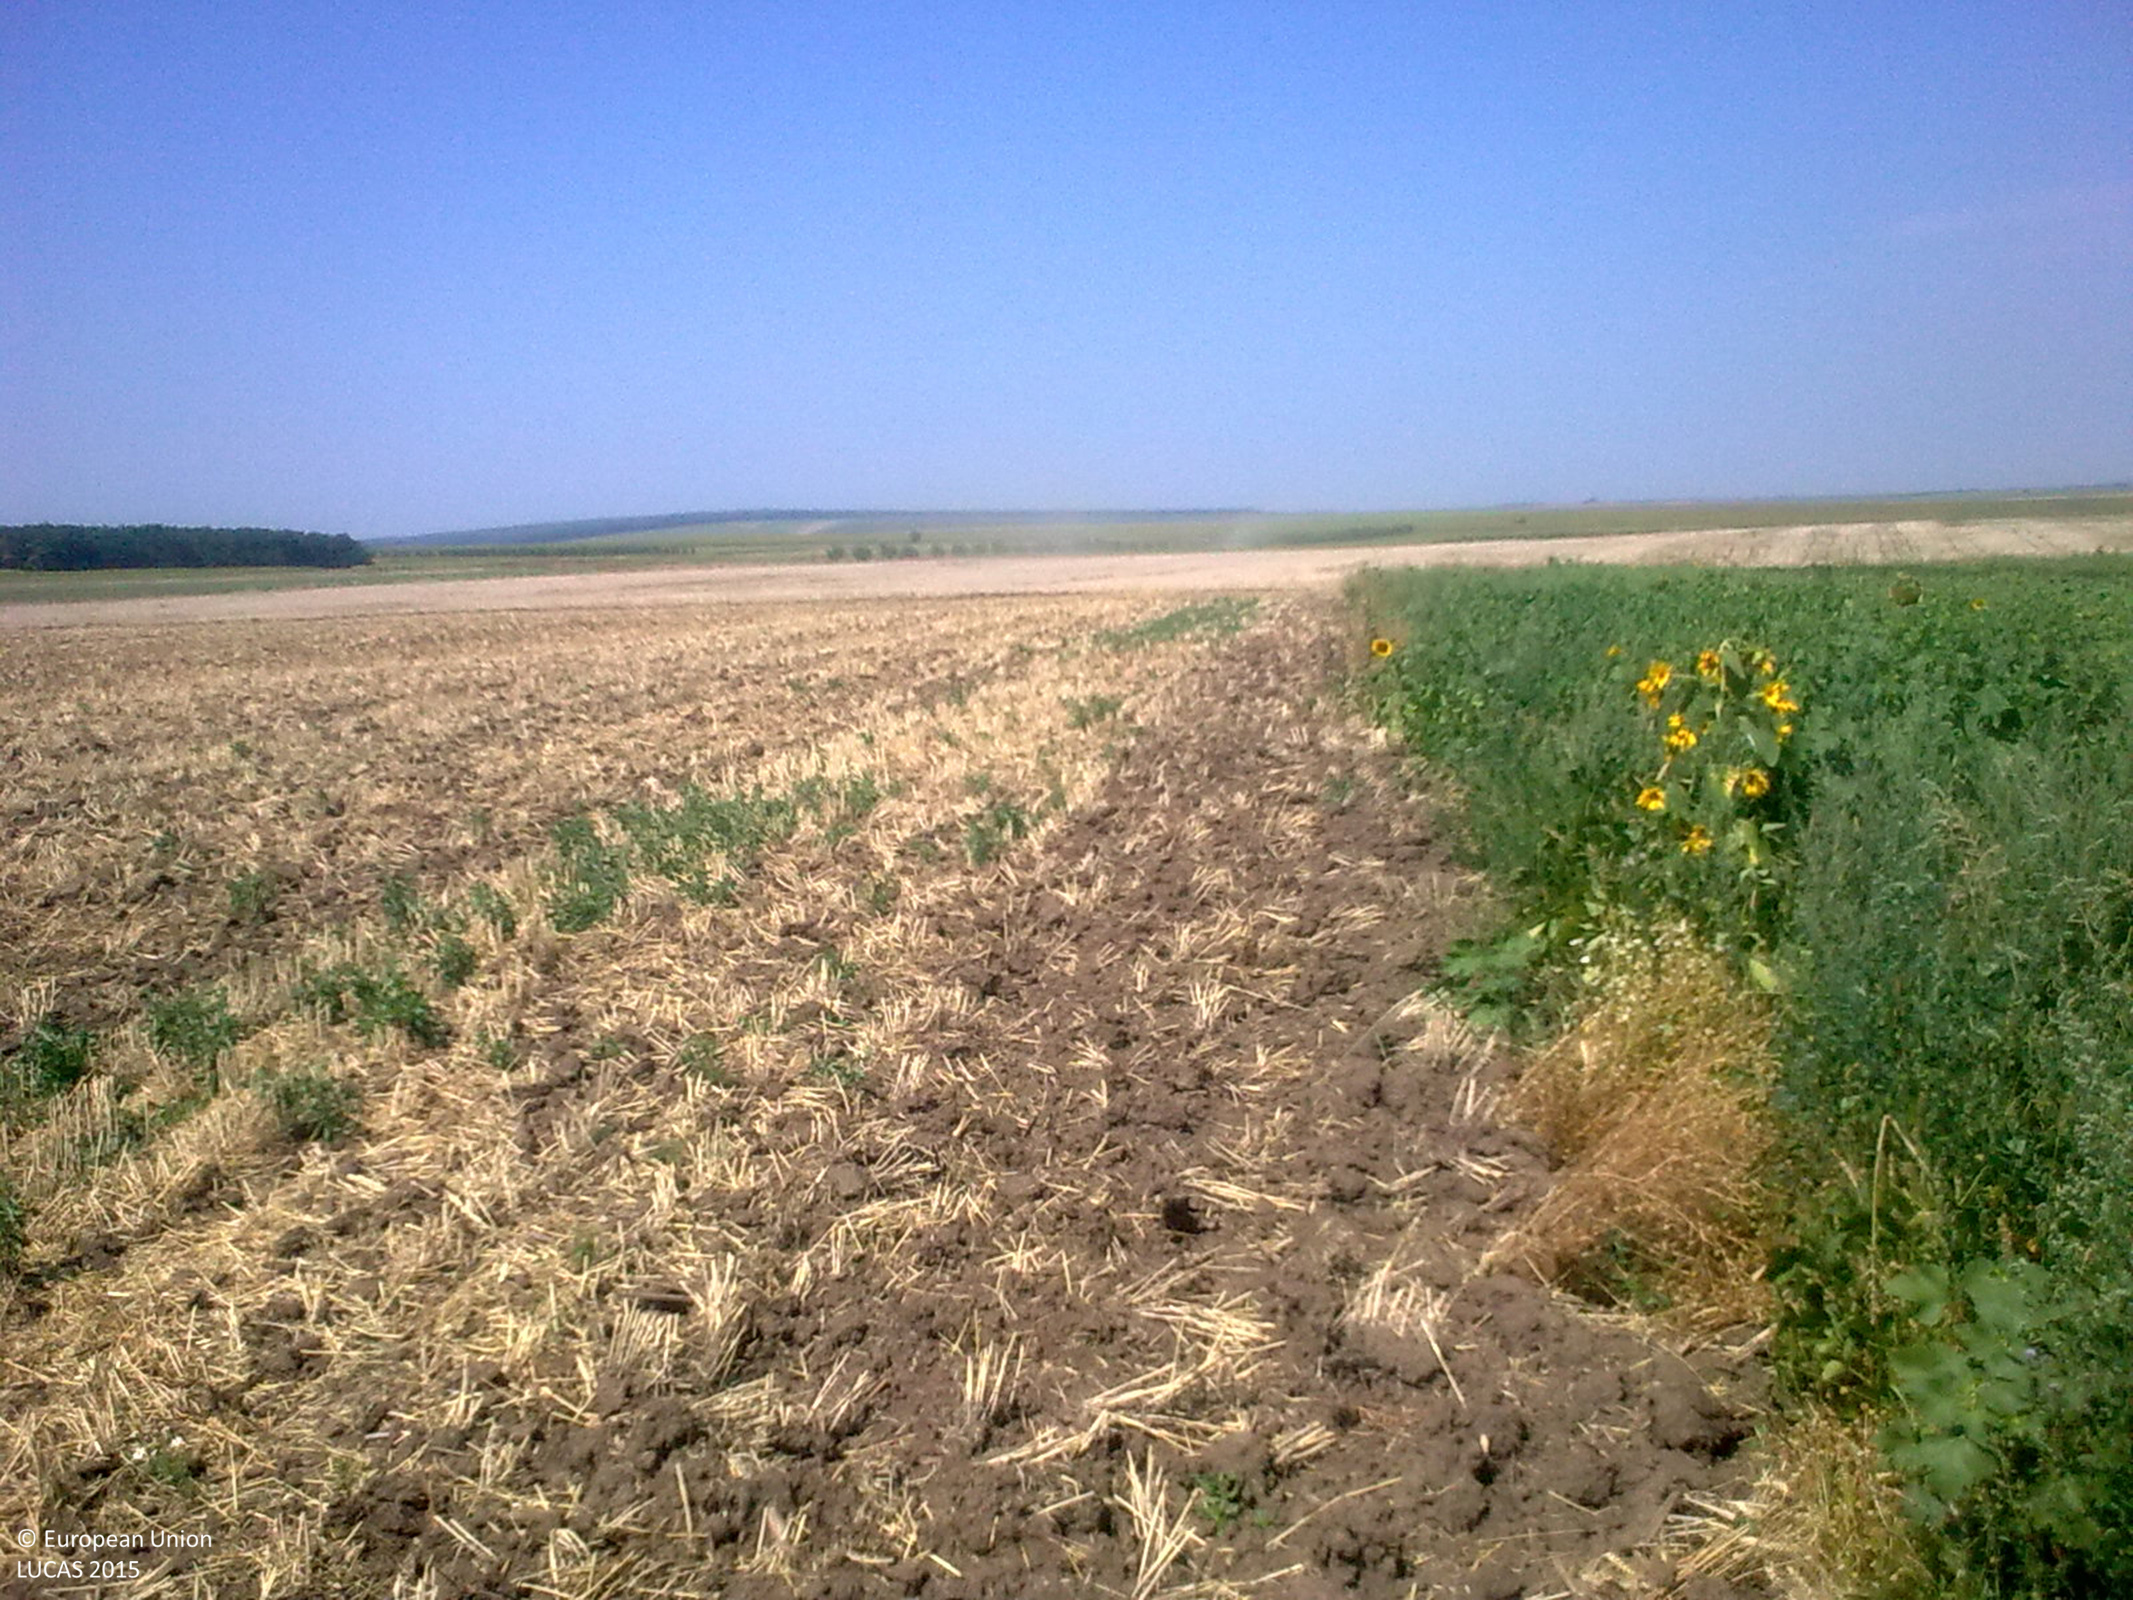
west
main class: Cropland
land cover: Soya
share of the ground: > 75 %
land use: Agriculture (excluding fallow land and kitchen gardens)
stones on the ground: < 10 %
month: July
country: BG
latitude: 43.7733
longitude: 26.2652
